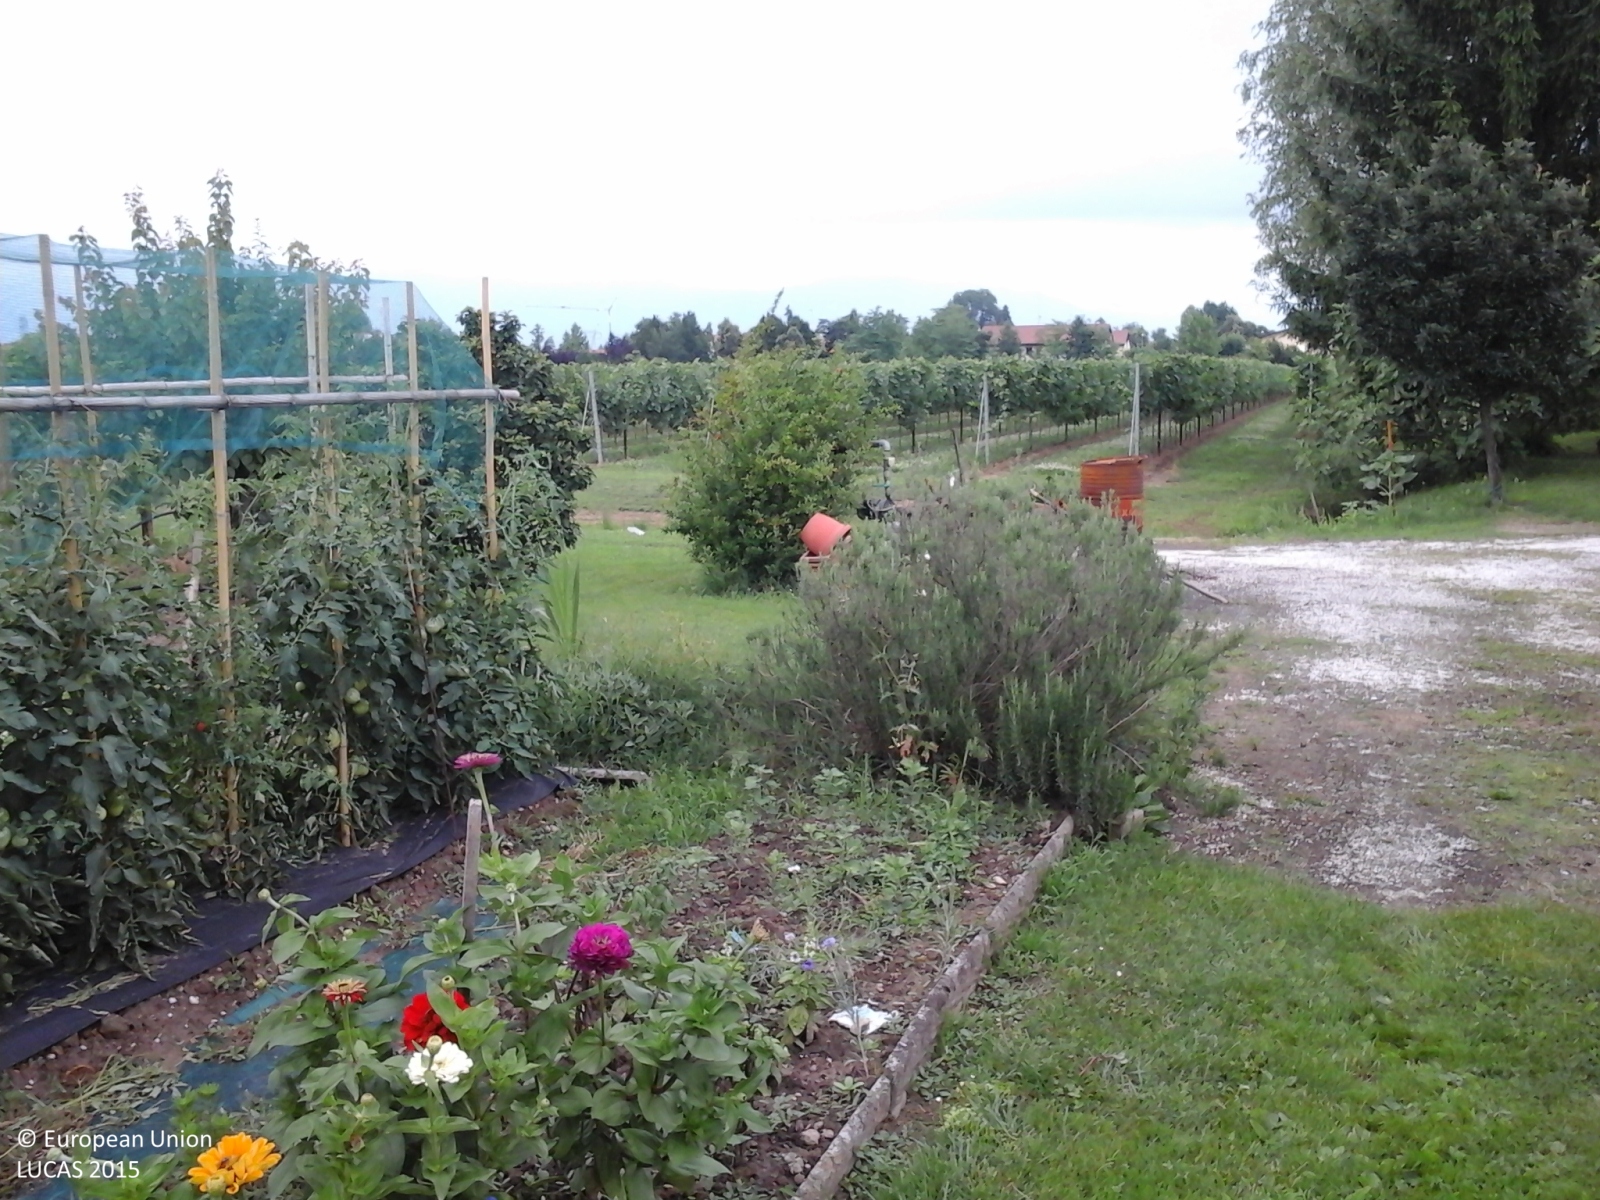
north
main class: Grassland
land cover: Grassland without tree/shrub cover
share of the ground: > 75 %
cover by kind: herbaceous plants 100 %
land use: Residential
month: June
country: IT
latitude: 45.8556
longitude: 12.4051
